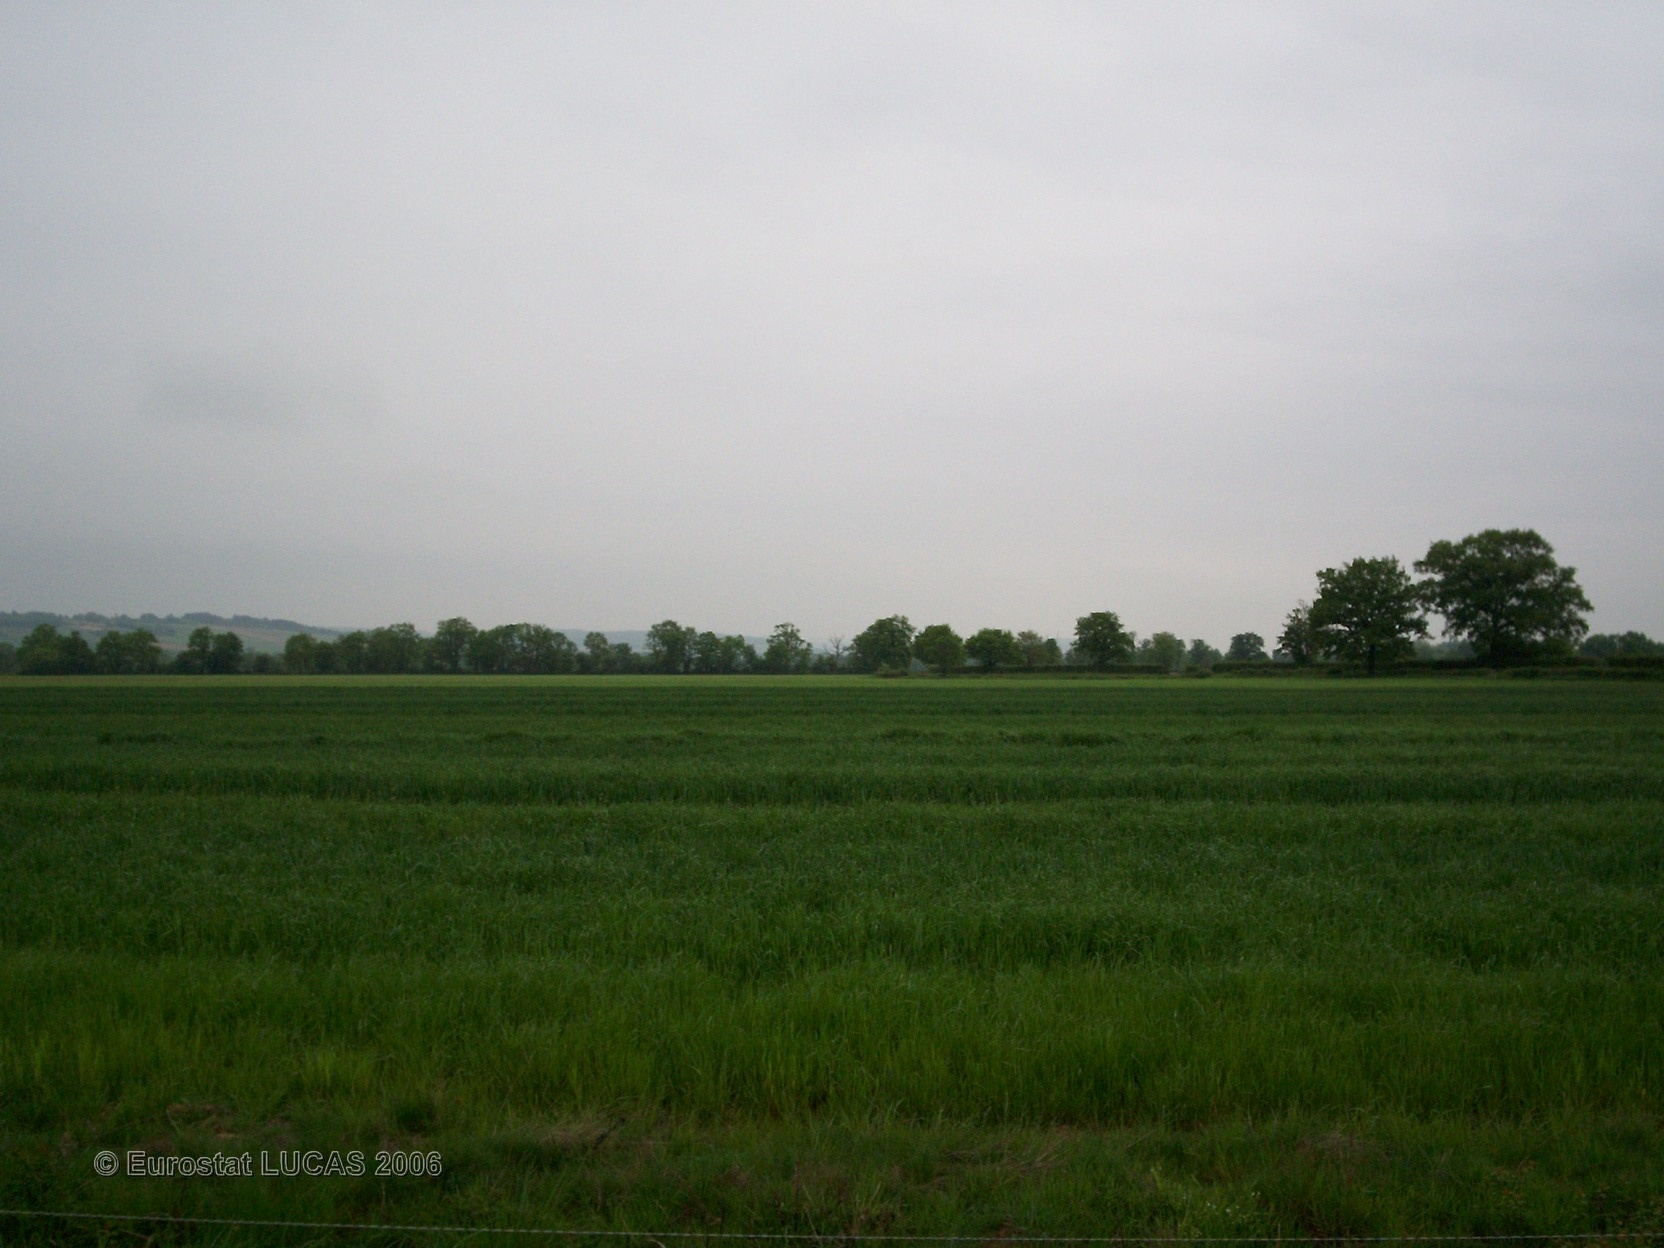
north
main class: Grassland
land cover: Grassland without tree/shrub cover
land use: Agriculture (excluding fallow land and kitchen gardens)
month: May
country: FR
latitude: 46.5431
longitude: 4.6679
